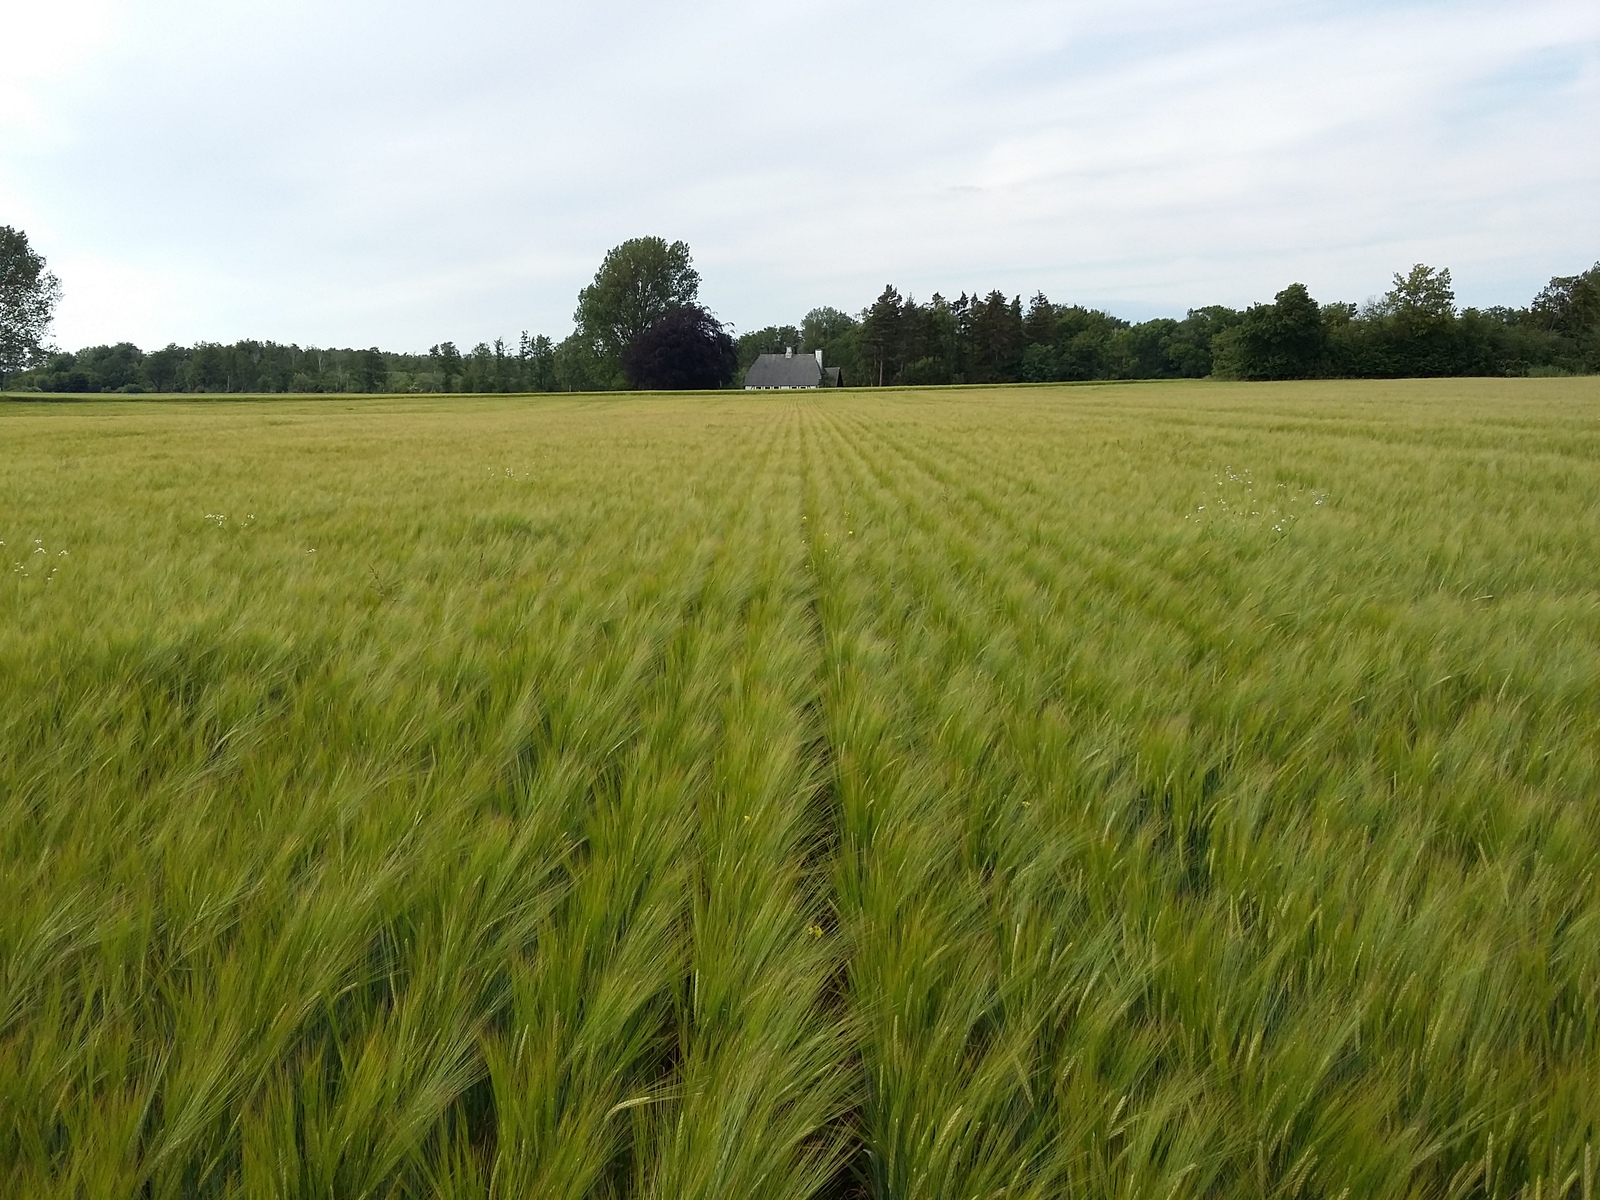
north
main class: Cropland
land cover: Barley
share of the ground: > 75 %
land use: Agriculture (excluding fallow land and kitchen gardens)
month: June
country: DK
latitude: 54.8056
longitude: 12.0057
